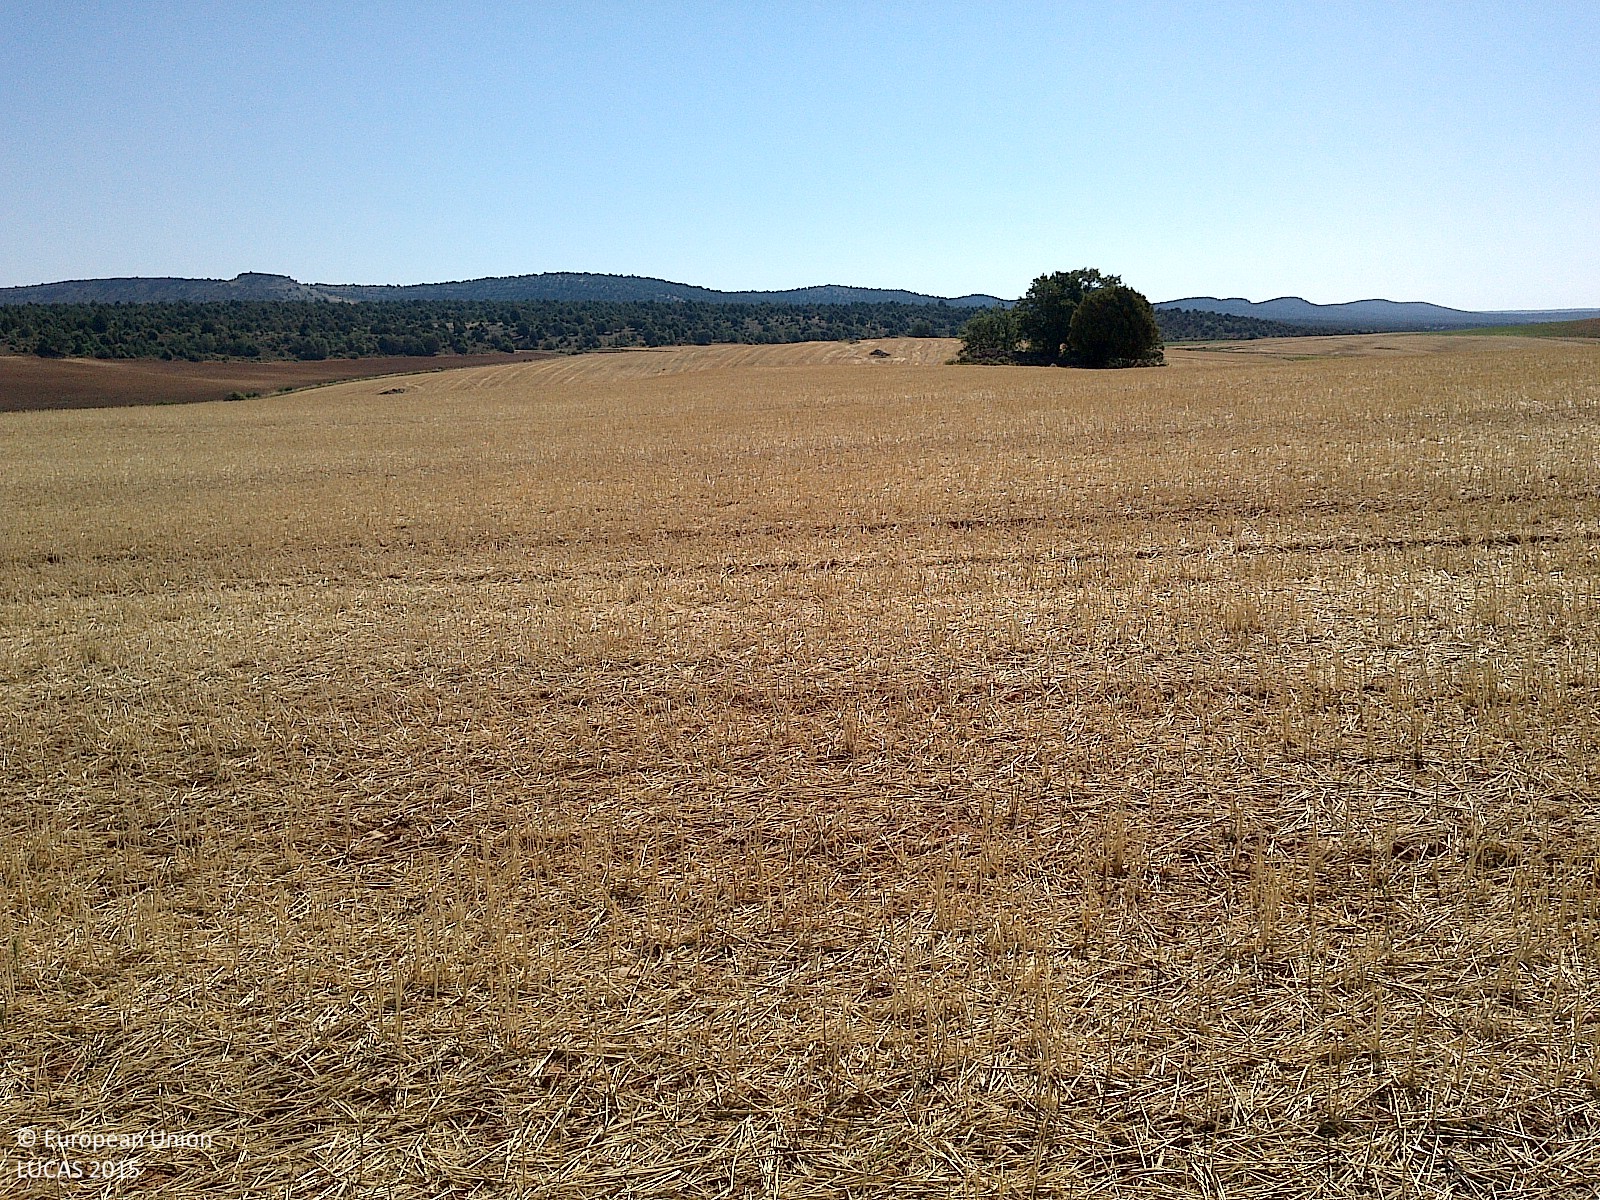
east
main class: Cropland
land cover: Durum wheat
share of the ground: < 10 %
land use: Agriculture (excluding fallow land and kitchen gardens)
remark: Harvested field
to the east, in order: Durum wheat; Grassland with sparse tree/shrub cover; Other bare soil
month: July
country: ES
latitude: 41.7537
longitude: -3.1674
